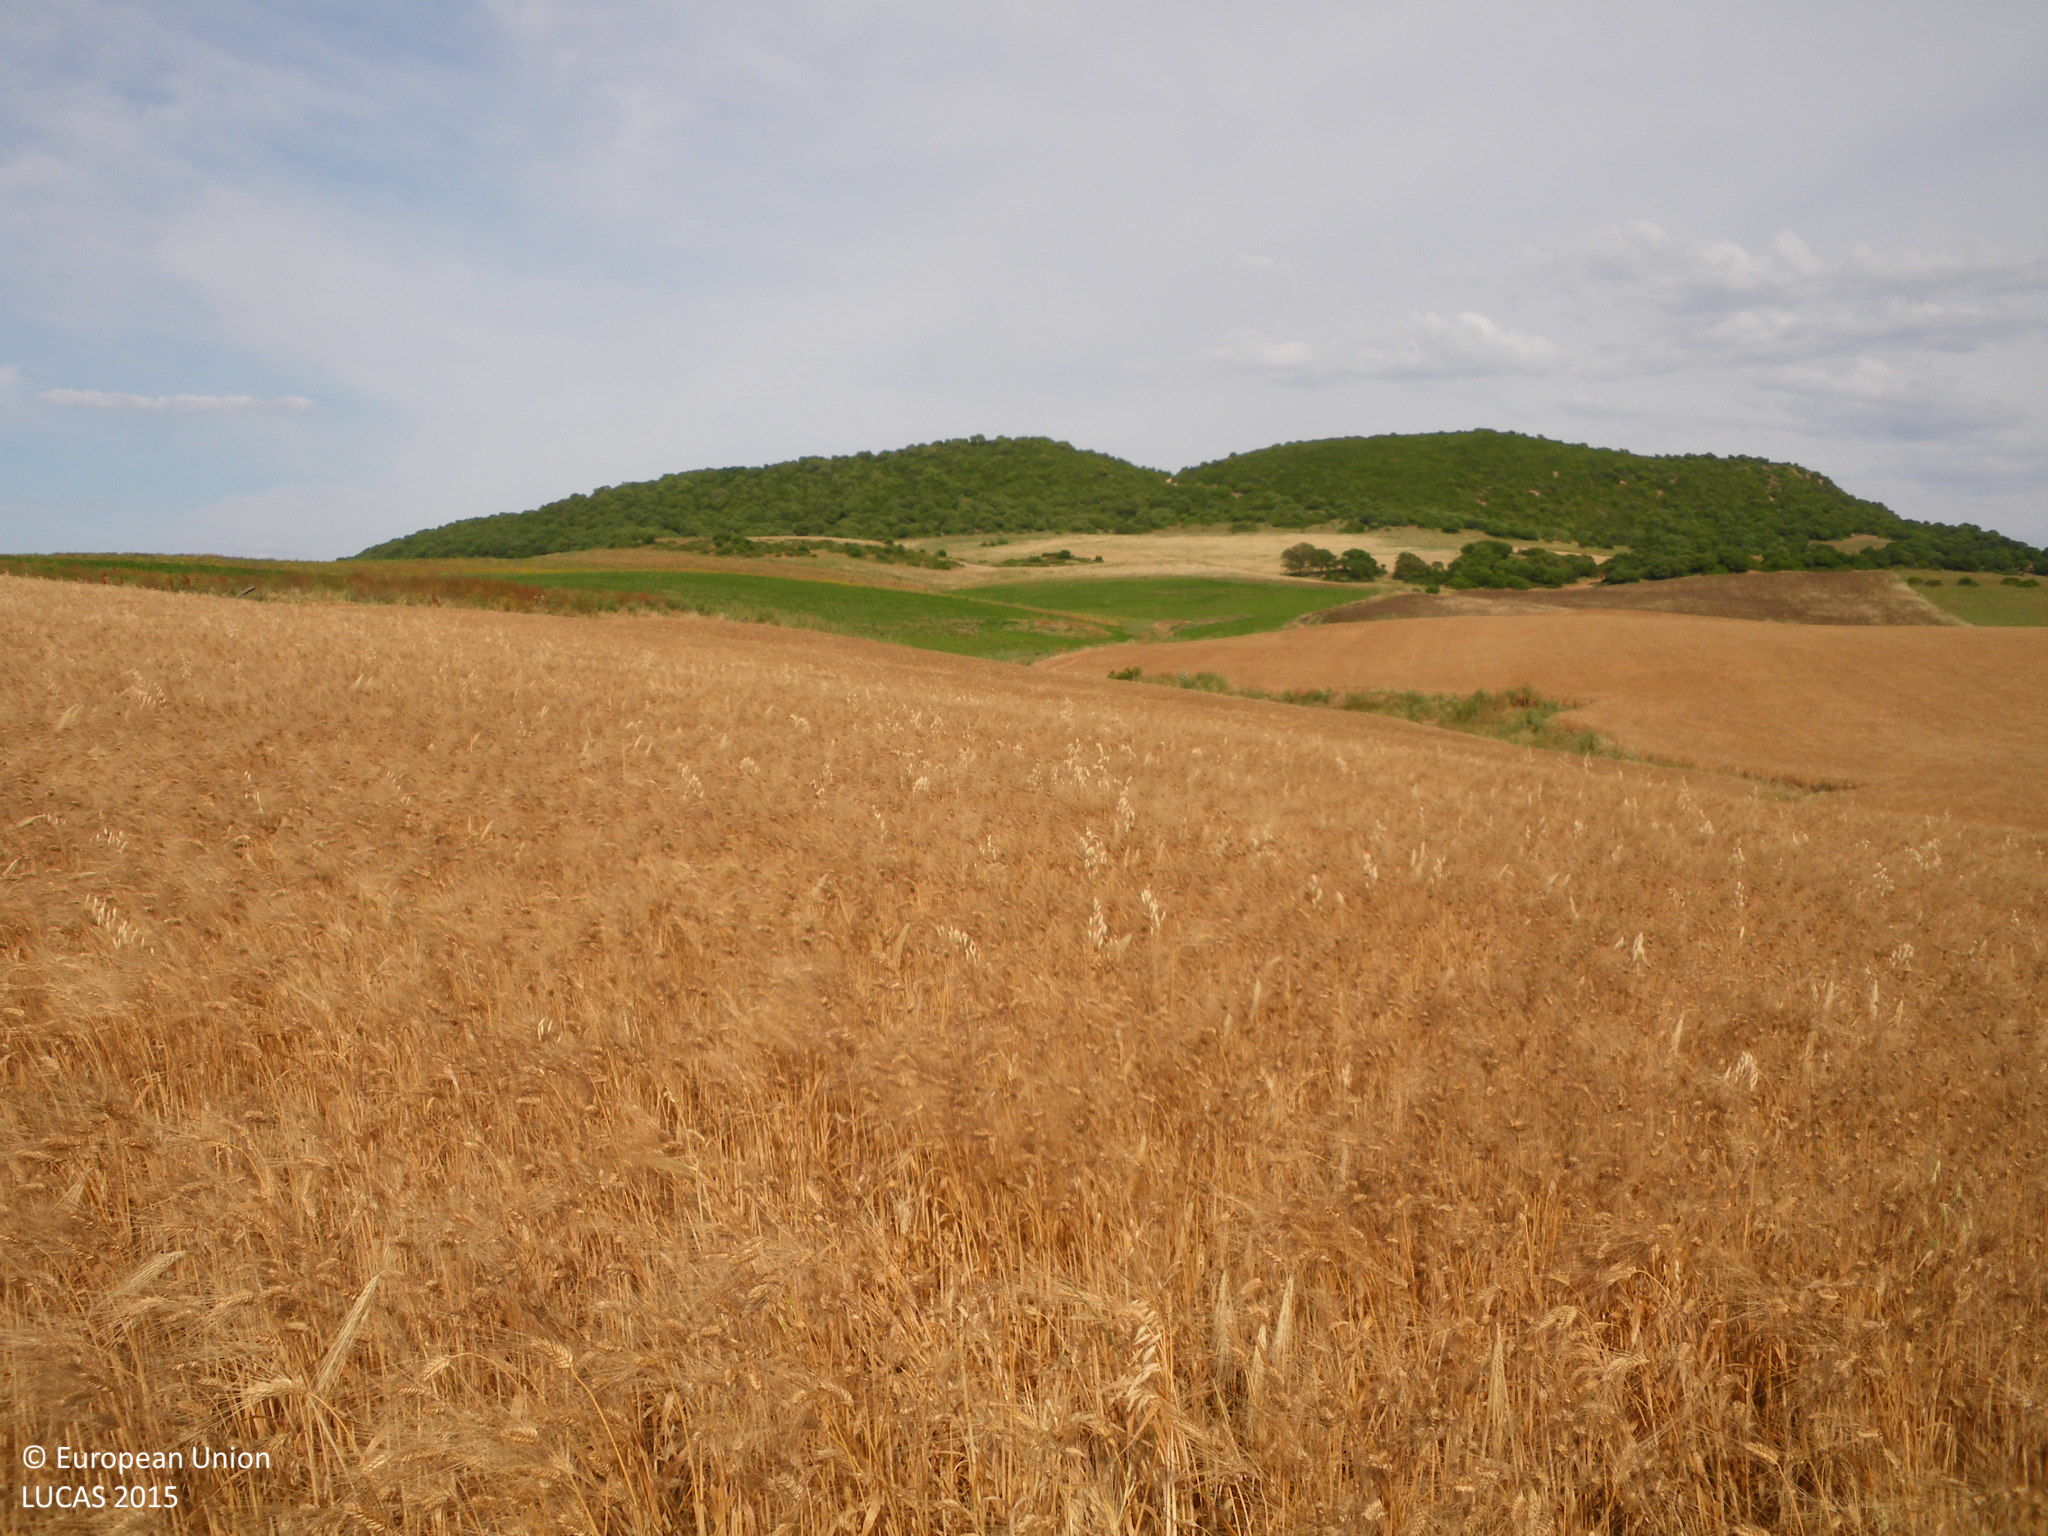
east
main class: Cropland
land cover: Durum wheat
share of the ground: > 75 %
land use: Agriculture (excluding fallow land and kitchen gardens)
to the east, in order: Durum wheat; Tracks; Grass margins; Fences; Grassland without tree/shrub cover; Other cereals
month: May
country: ES
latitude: 36.3589
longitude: -5.9274
